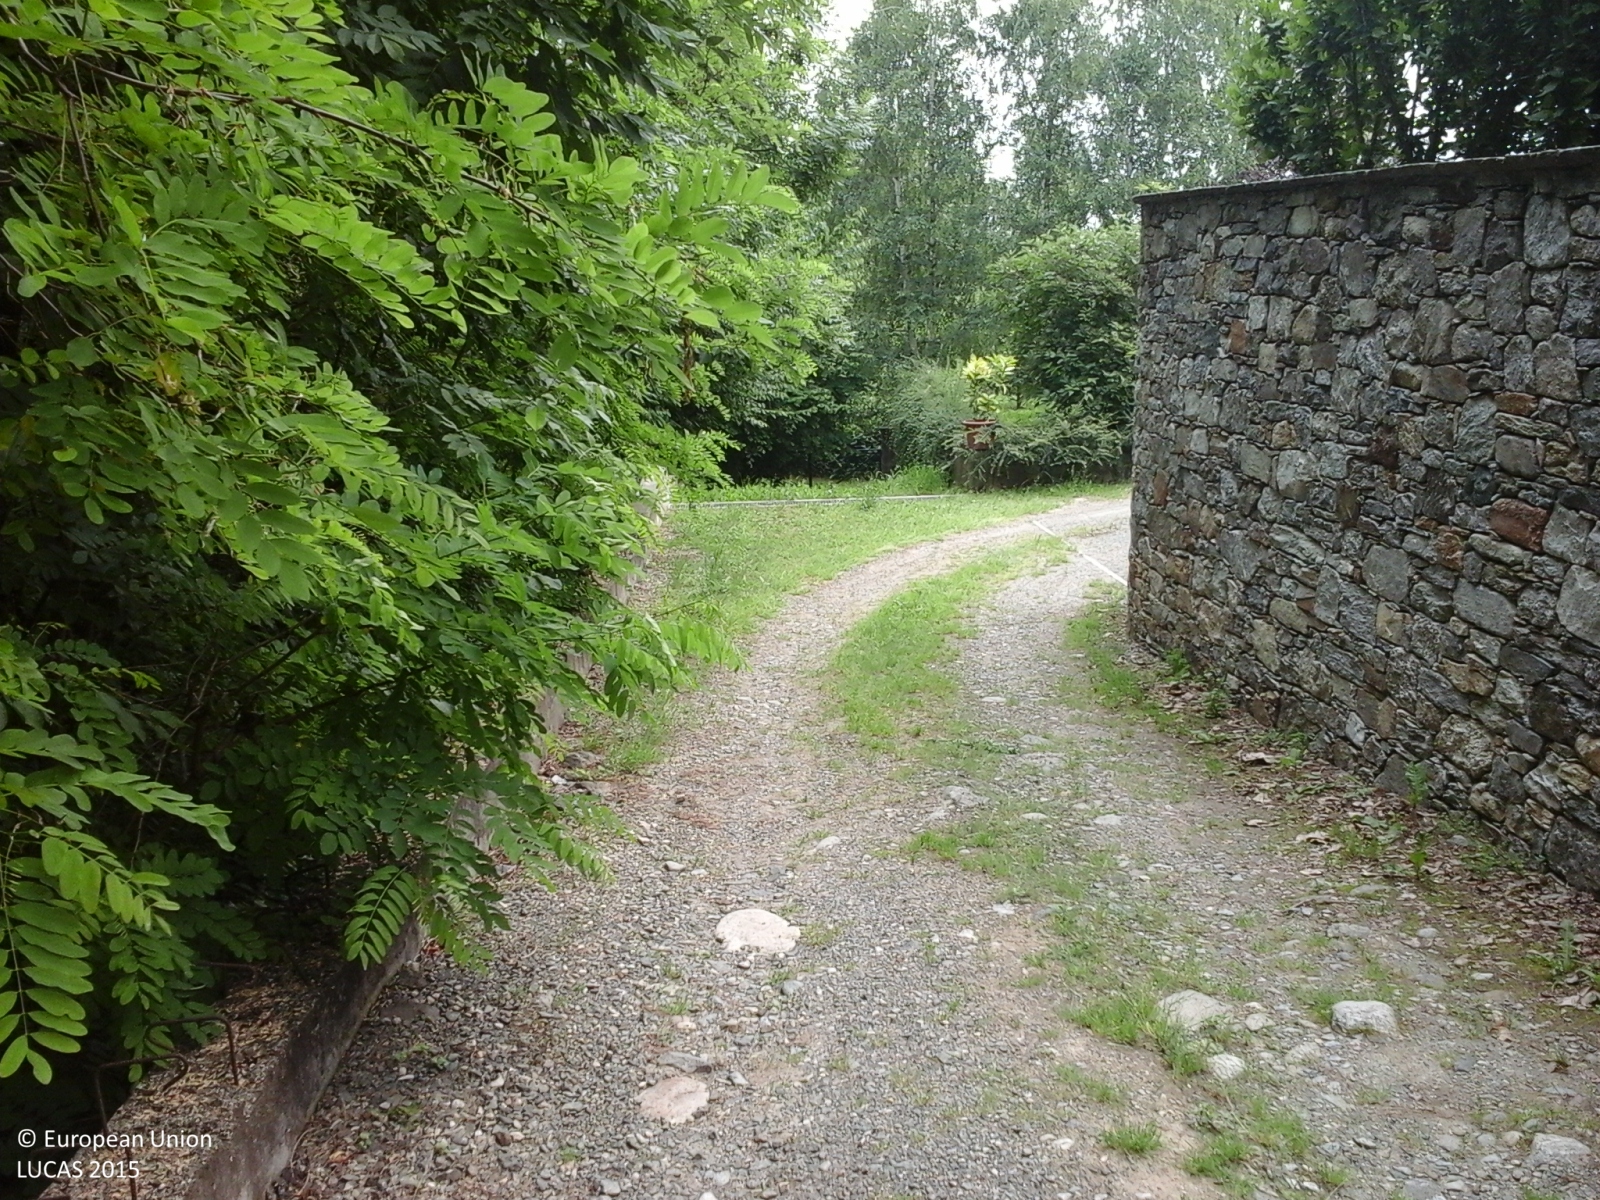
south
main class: Woodland
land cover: Broadleaved woodland
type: thermophilous deciduous forest
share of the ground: > 75 %
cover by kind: broadleaved forest trees 100 %
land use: Semi-natural and natural areas not in use
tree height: > 5 m
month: May
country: IT
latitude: 45.3896
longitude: 7.7173
